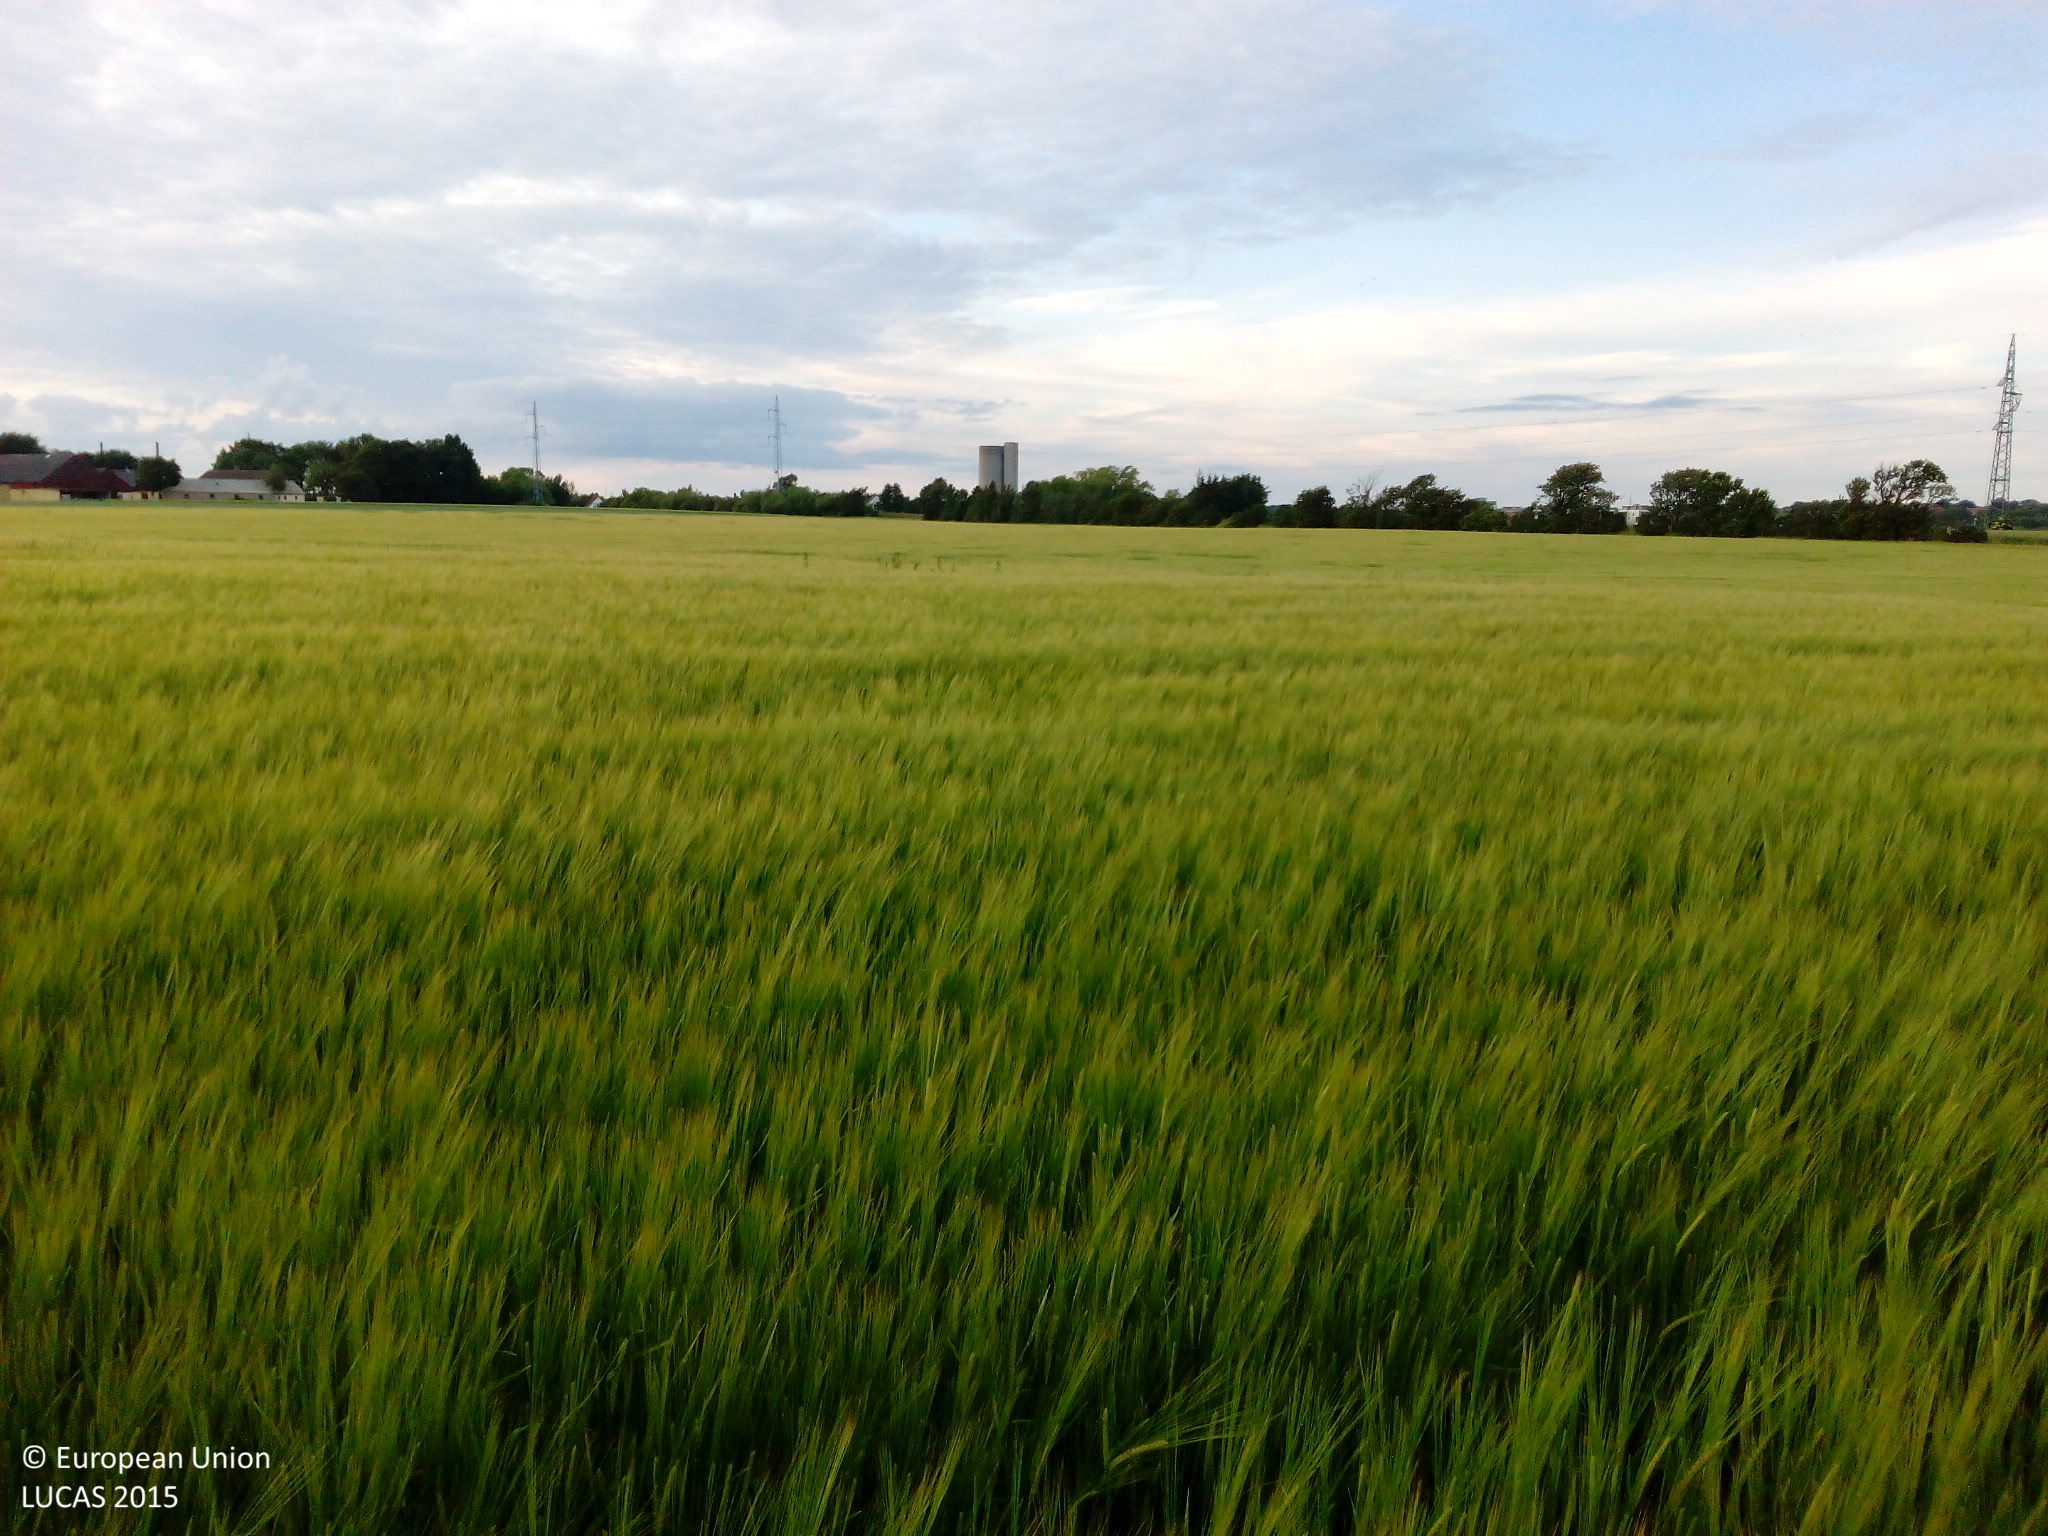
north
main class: Cropland
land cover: Barley
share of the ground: > 75 %
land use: Agriculture (excluding fallow land and kitchen gardens)
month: June
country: DK
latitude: 54.9872
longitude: 11.8897
